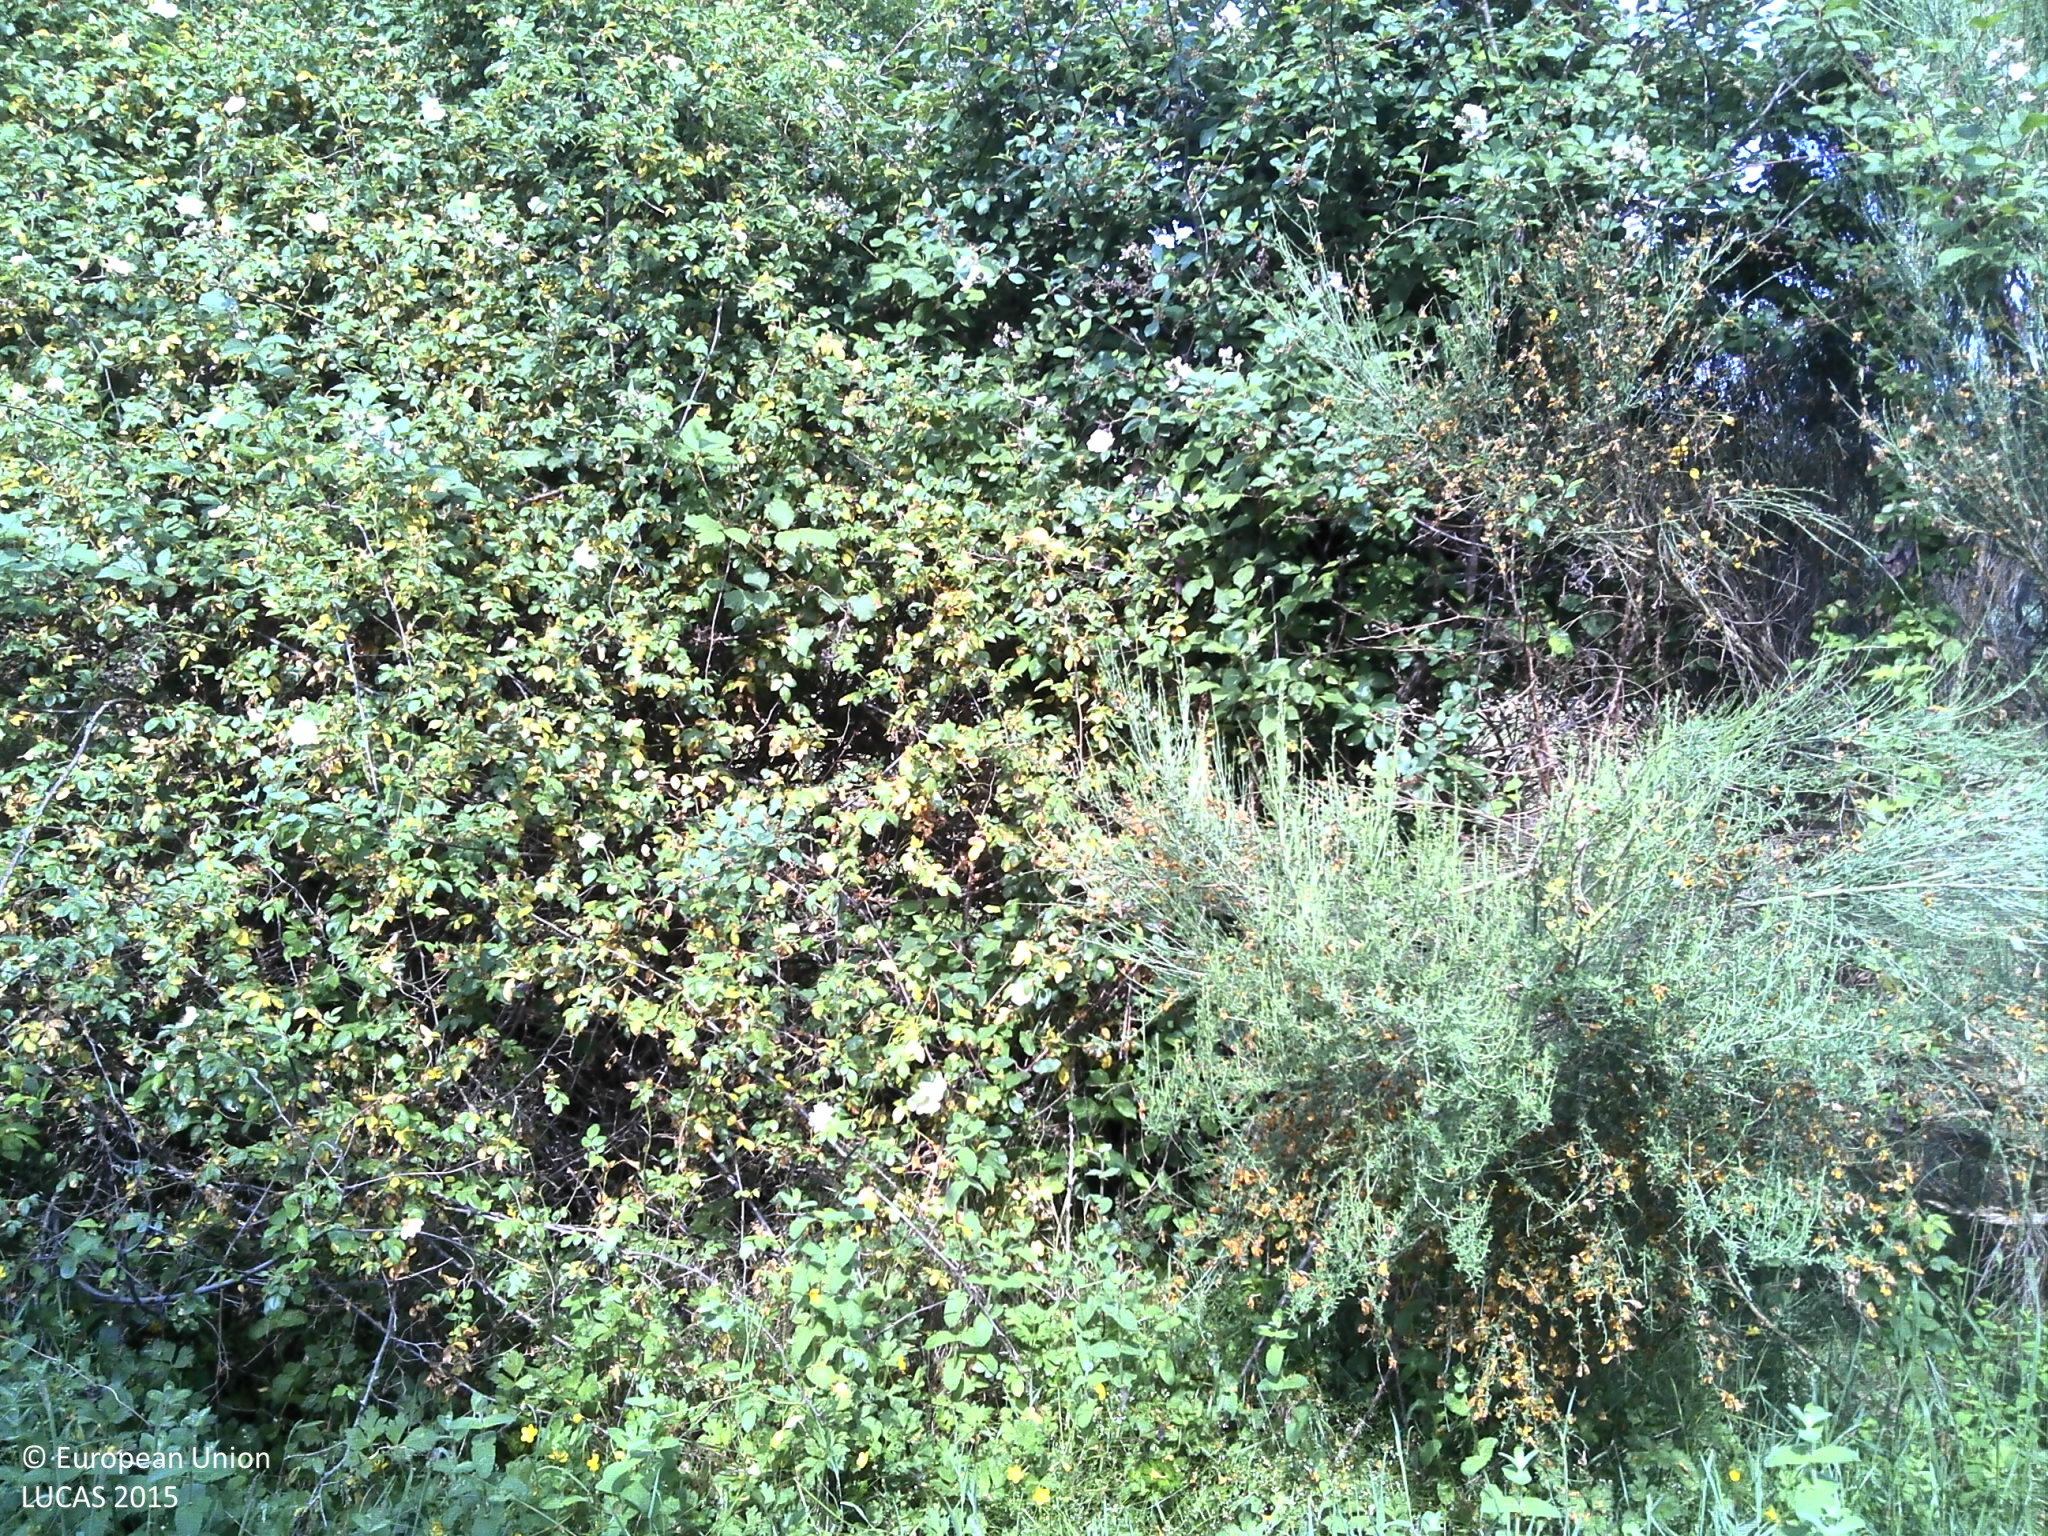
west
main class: Shrubland
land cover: Shrubland with sparse tree cover
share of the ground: > 75 %
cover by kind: shrubs 85 %, herbaceous plants 10 %, broadleaved forest trees 5 %
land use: Semi-natural and natural areas not in use
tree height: > 5 m
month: June
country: PT
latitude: 41.4275
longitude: -7.5132
